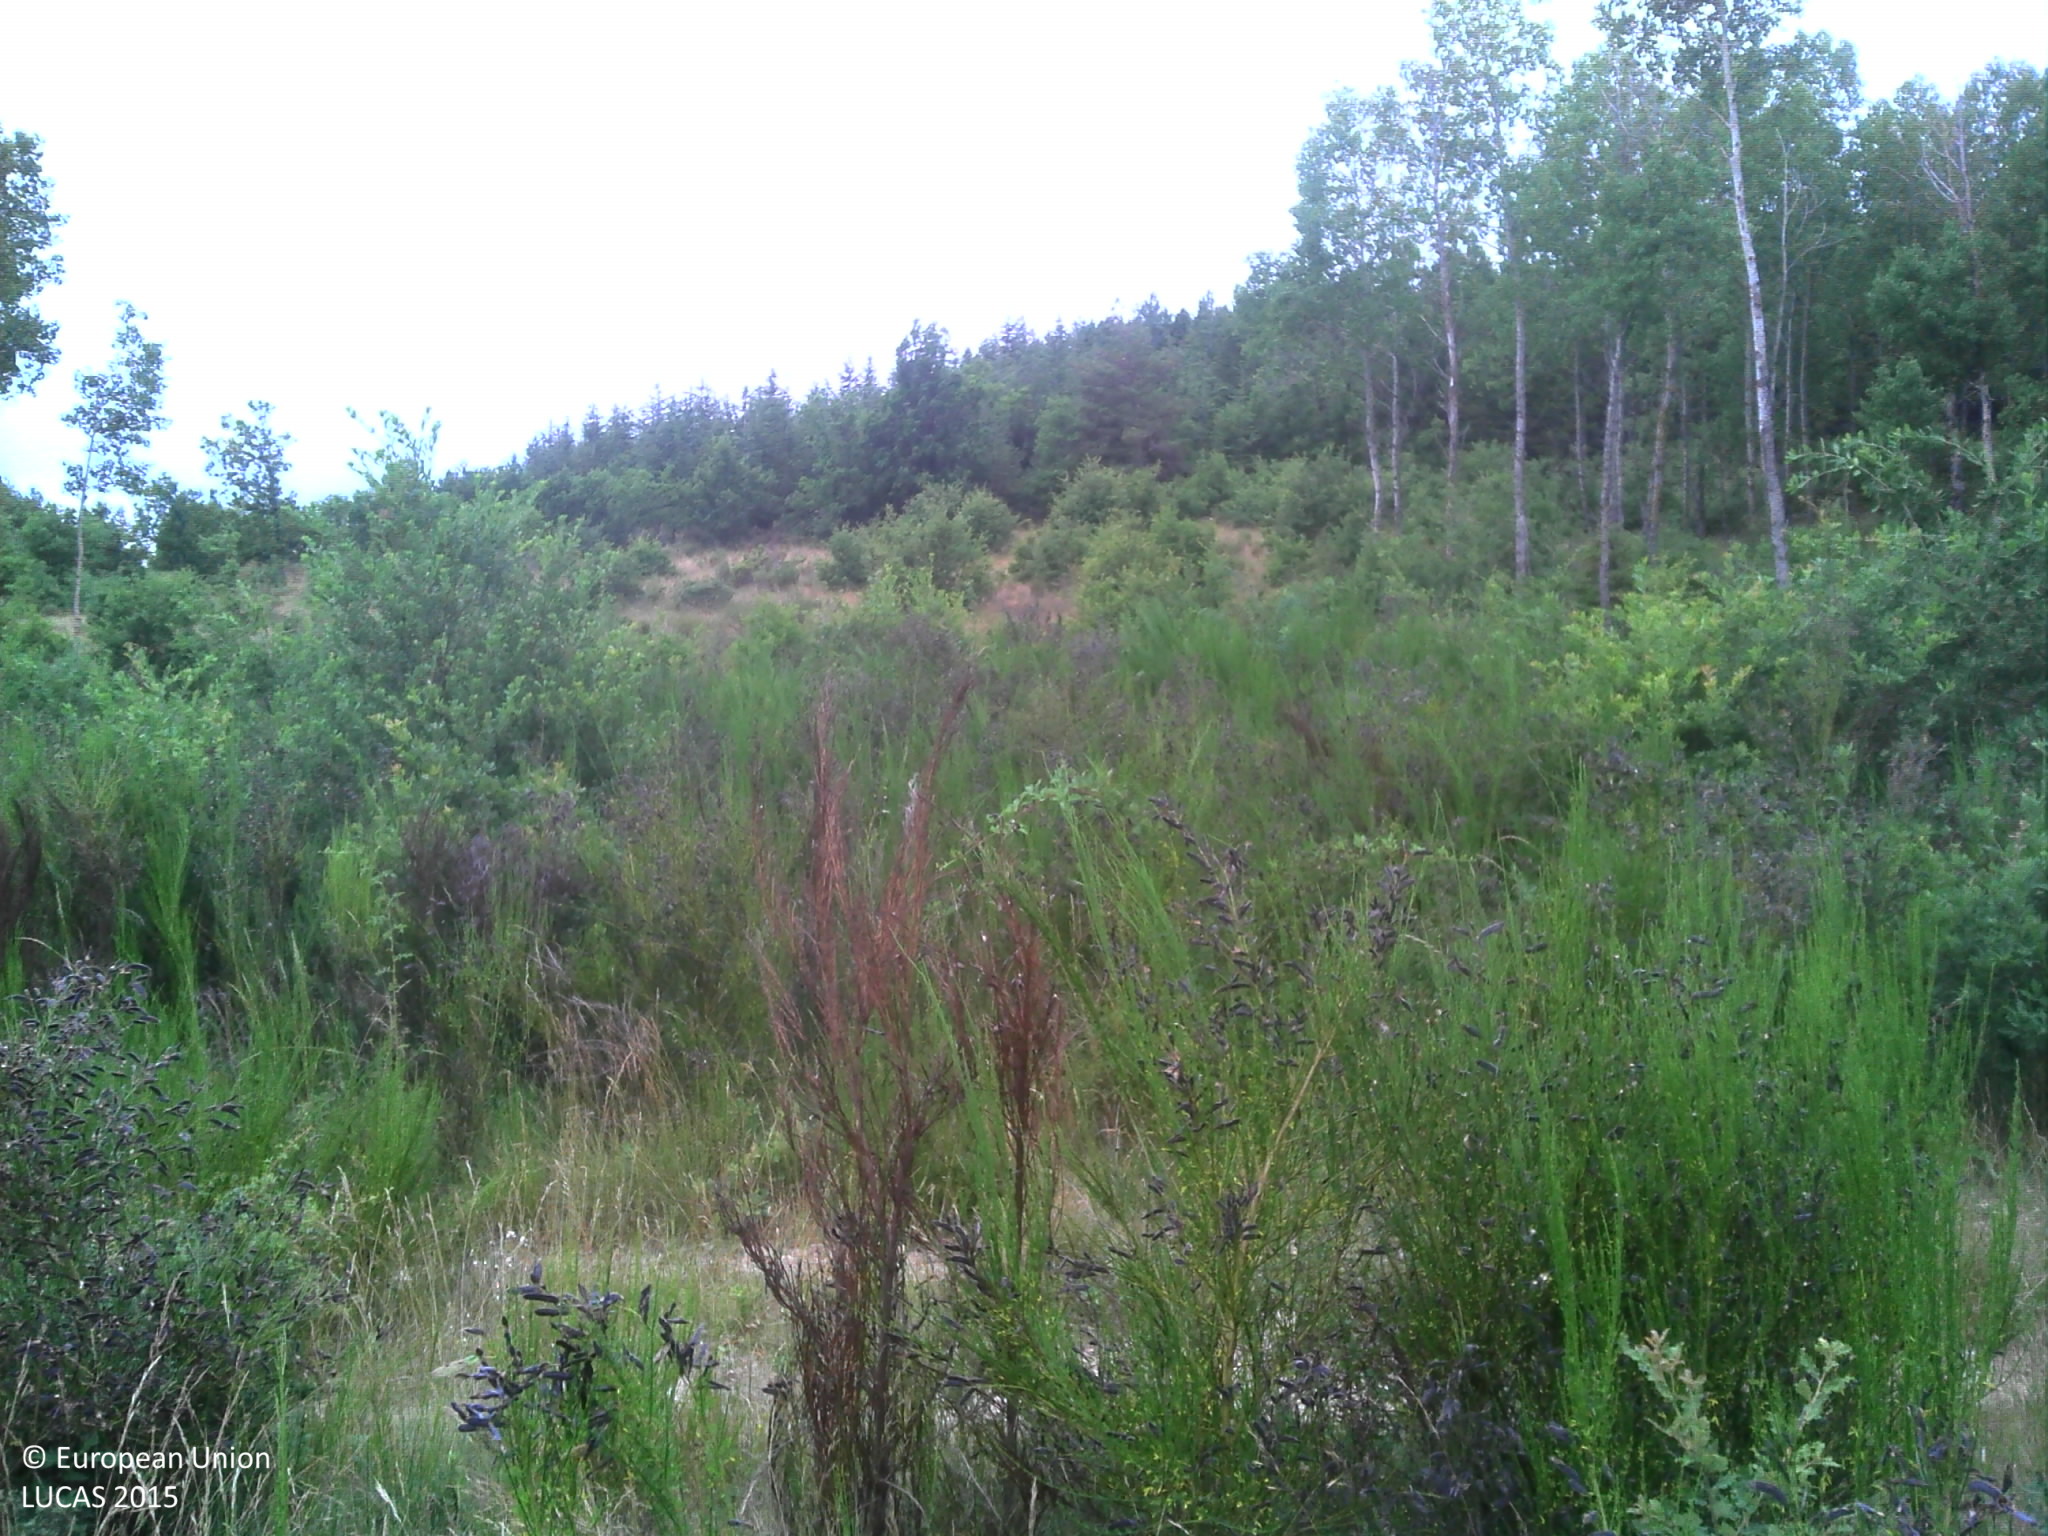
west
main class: Shrubland
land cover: Shrubland with sparse tree cover
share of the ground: > 75 %
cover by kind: shrubs 50 %, herbaceous plants 45 %, broadleaved forest trees 5 %
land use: Agriculture (excluding fallow land and kitchen gardens)
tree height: < 5 m
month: July
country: FR
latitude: 44.0936
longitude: 5.5739
